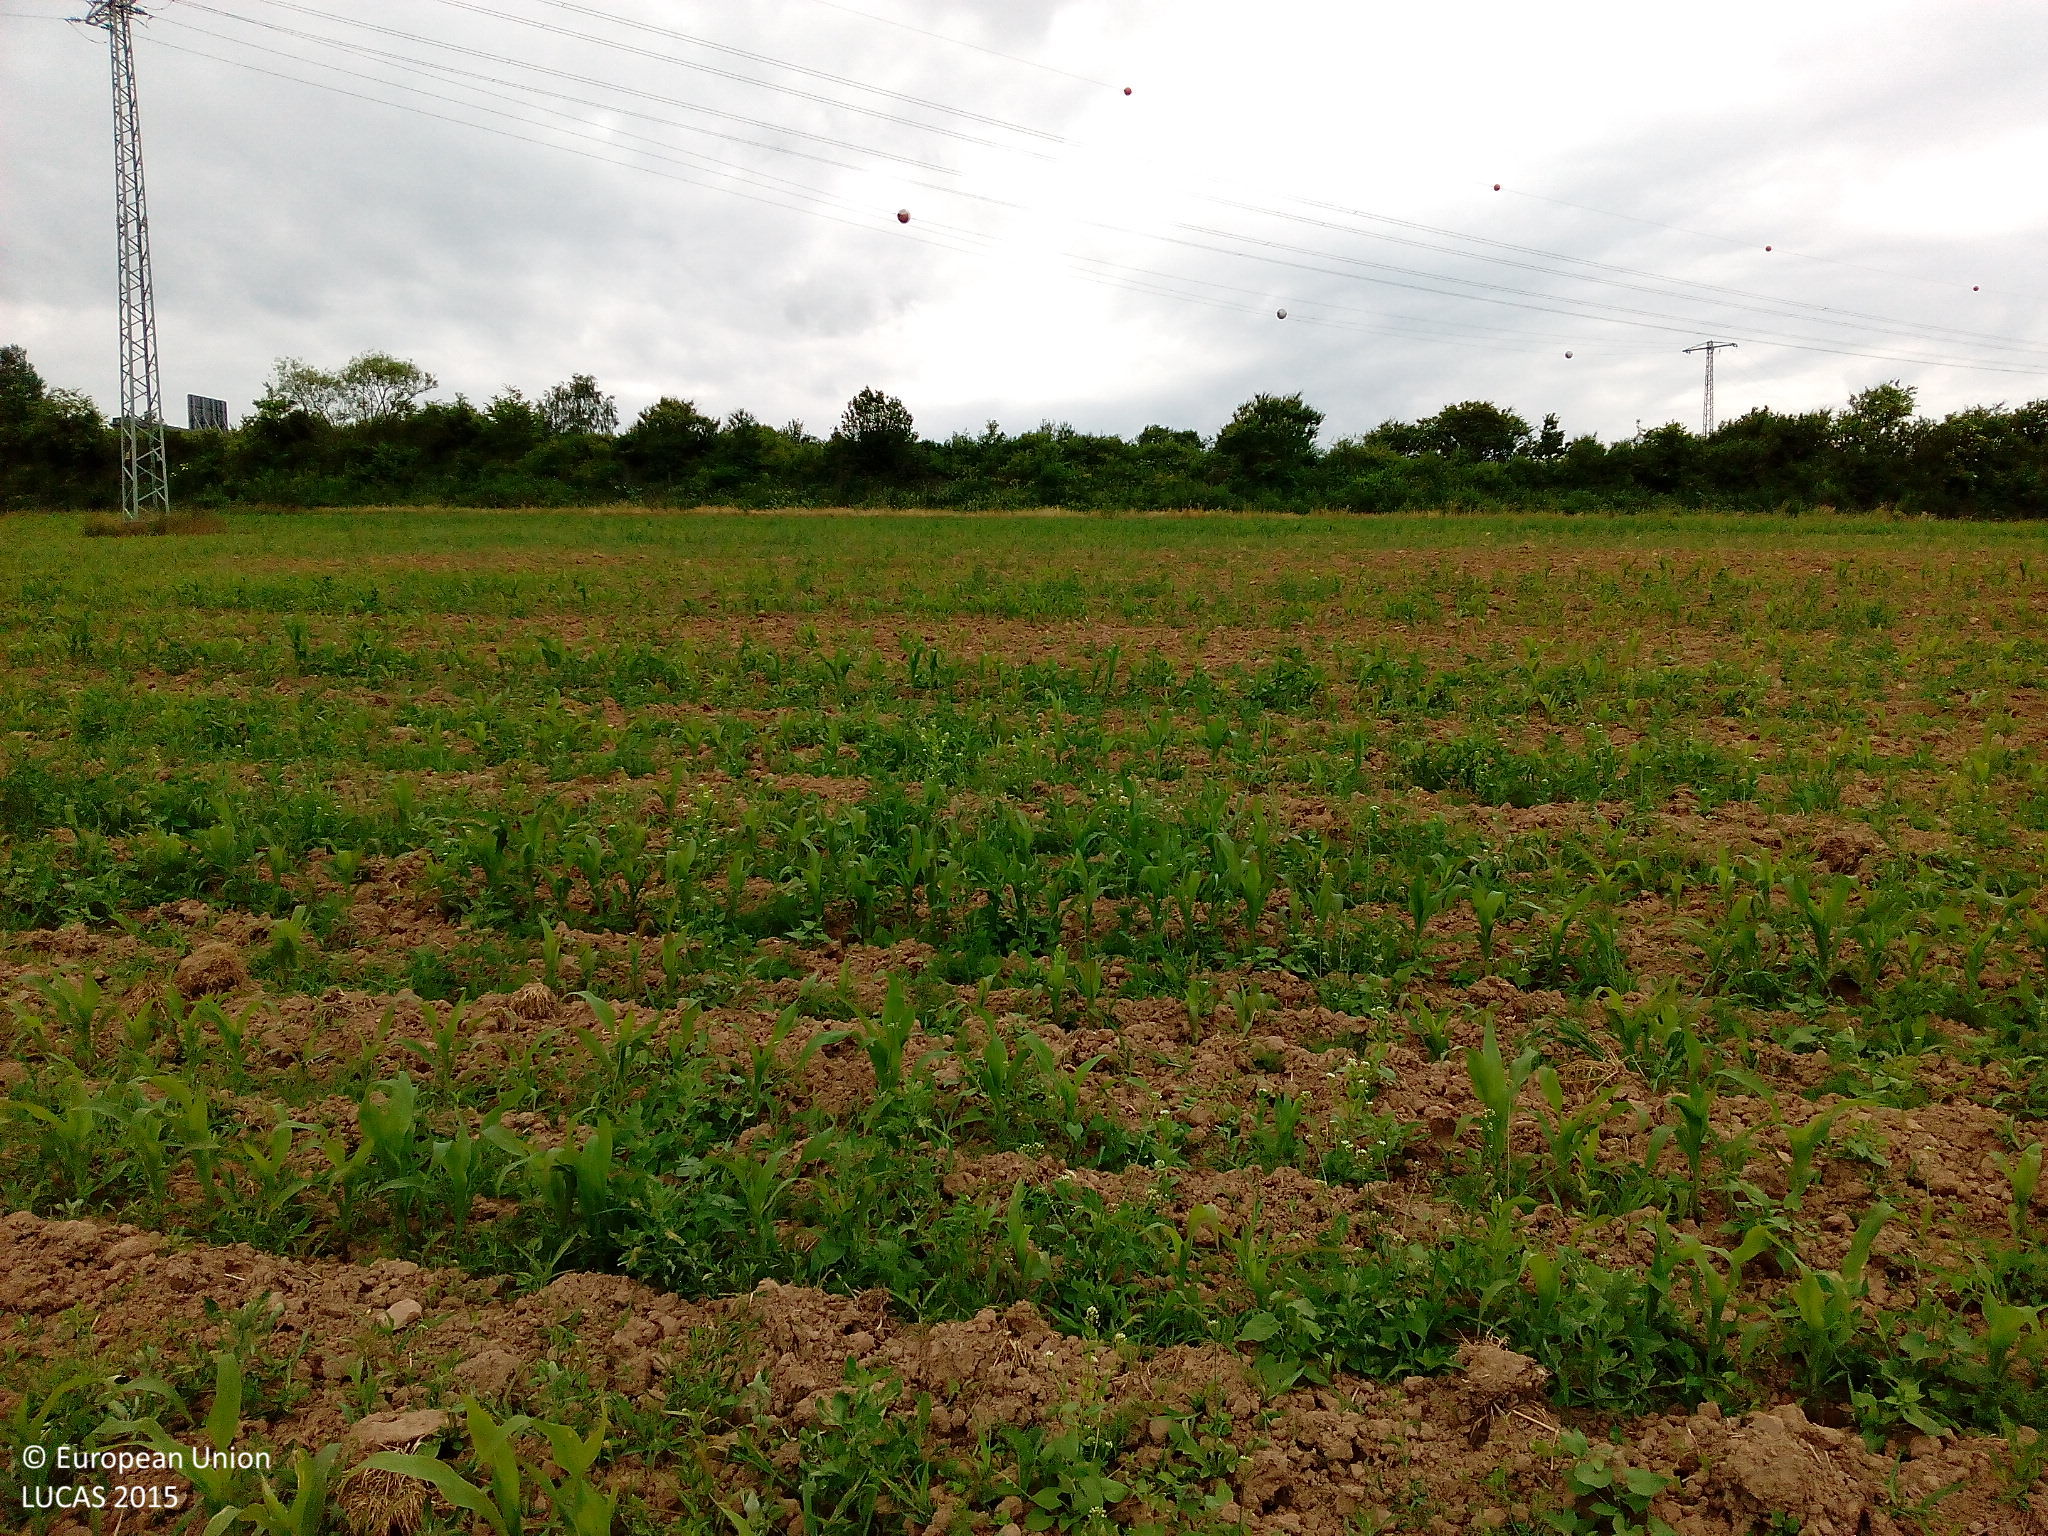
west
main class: Cropland
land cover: Maize
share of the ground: 25 - 50 %
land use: Agriculture (excluding fallow land and kitchen gardens)
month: June
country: DE
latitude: 50.9027
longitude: 9.5877
